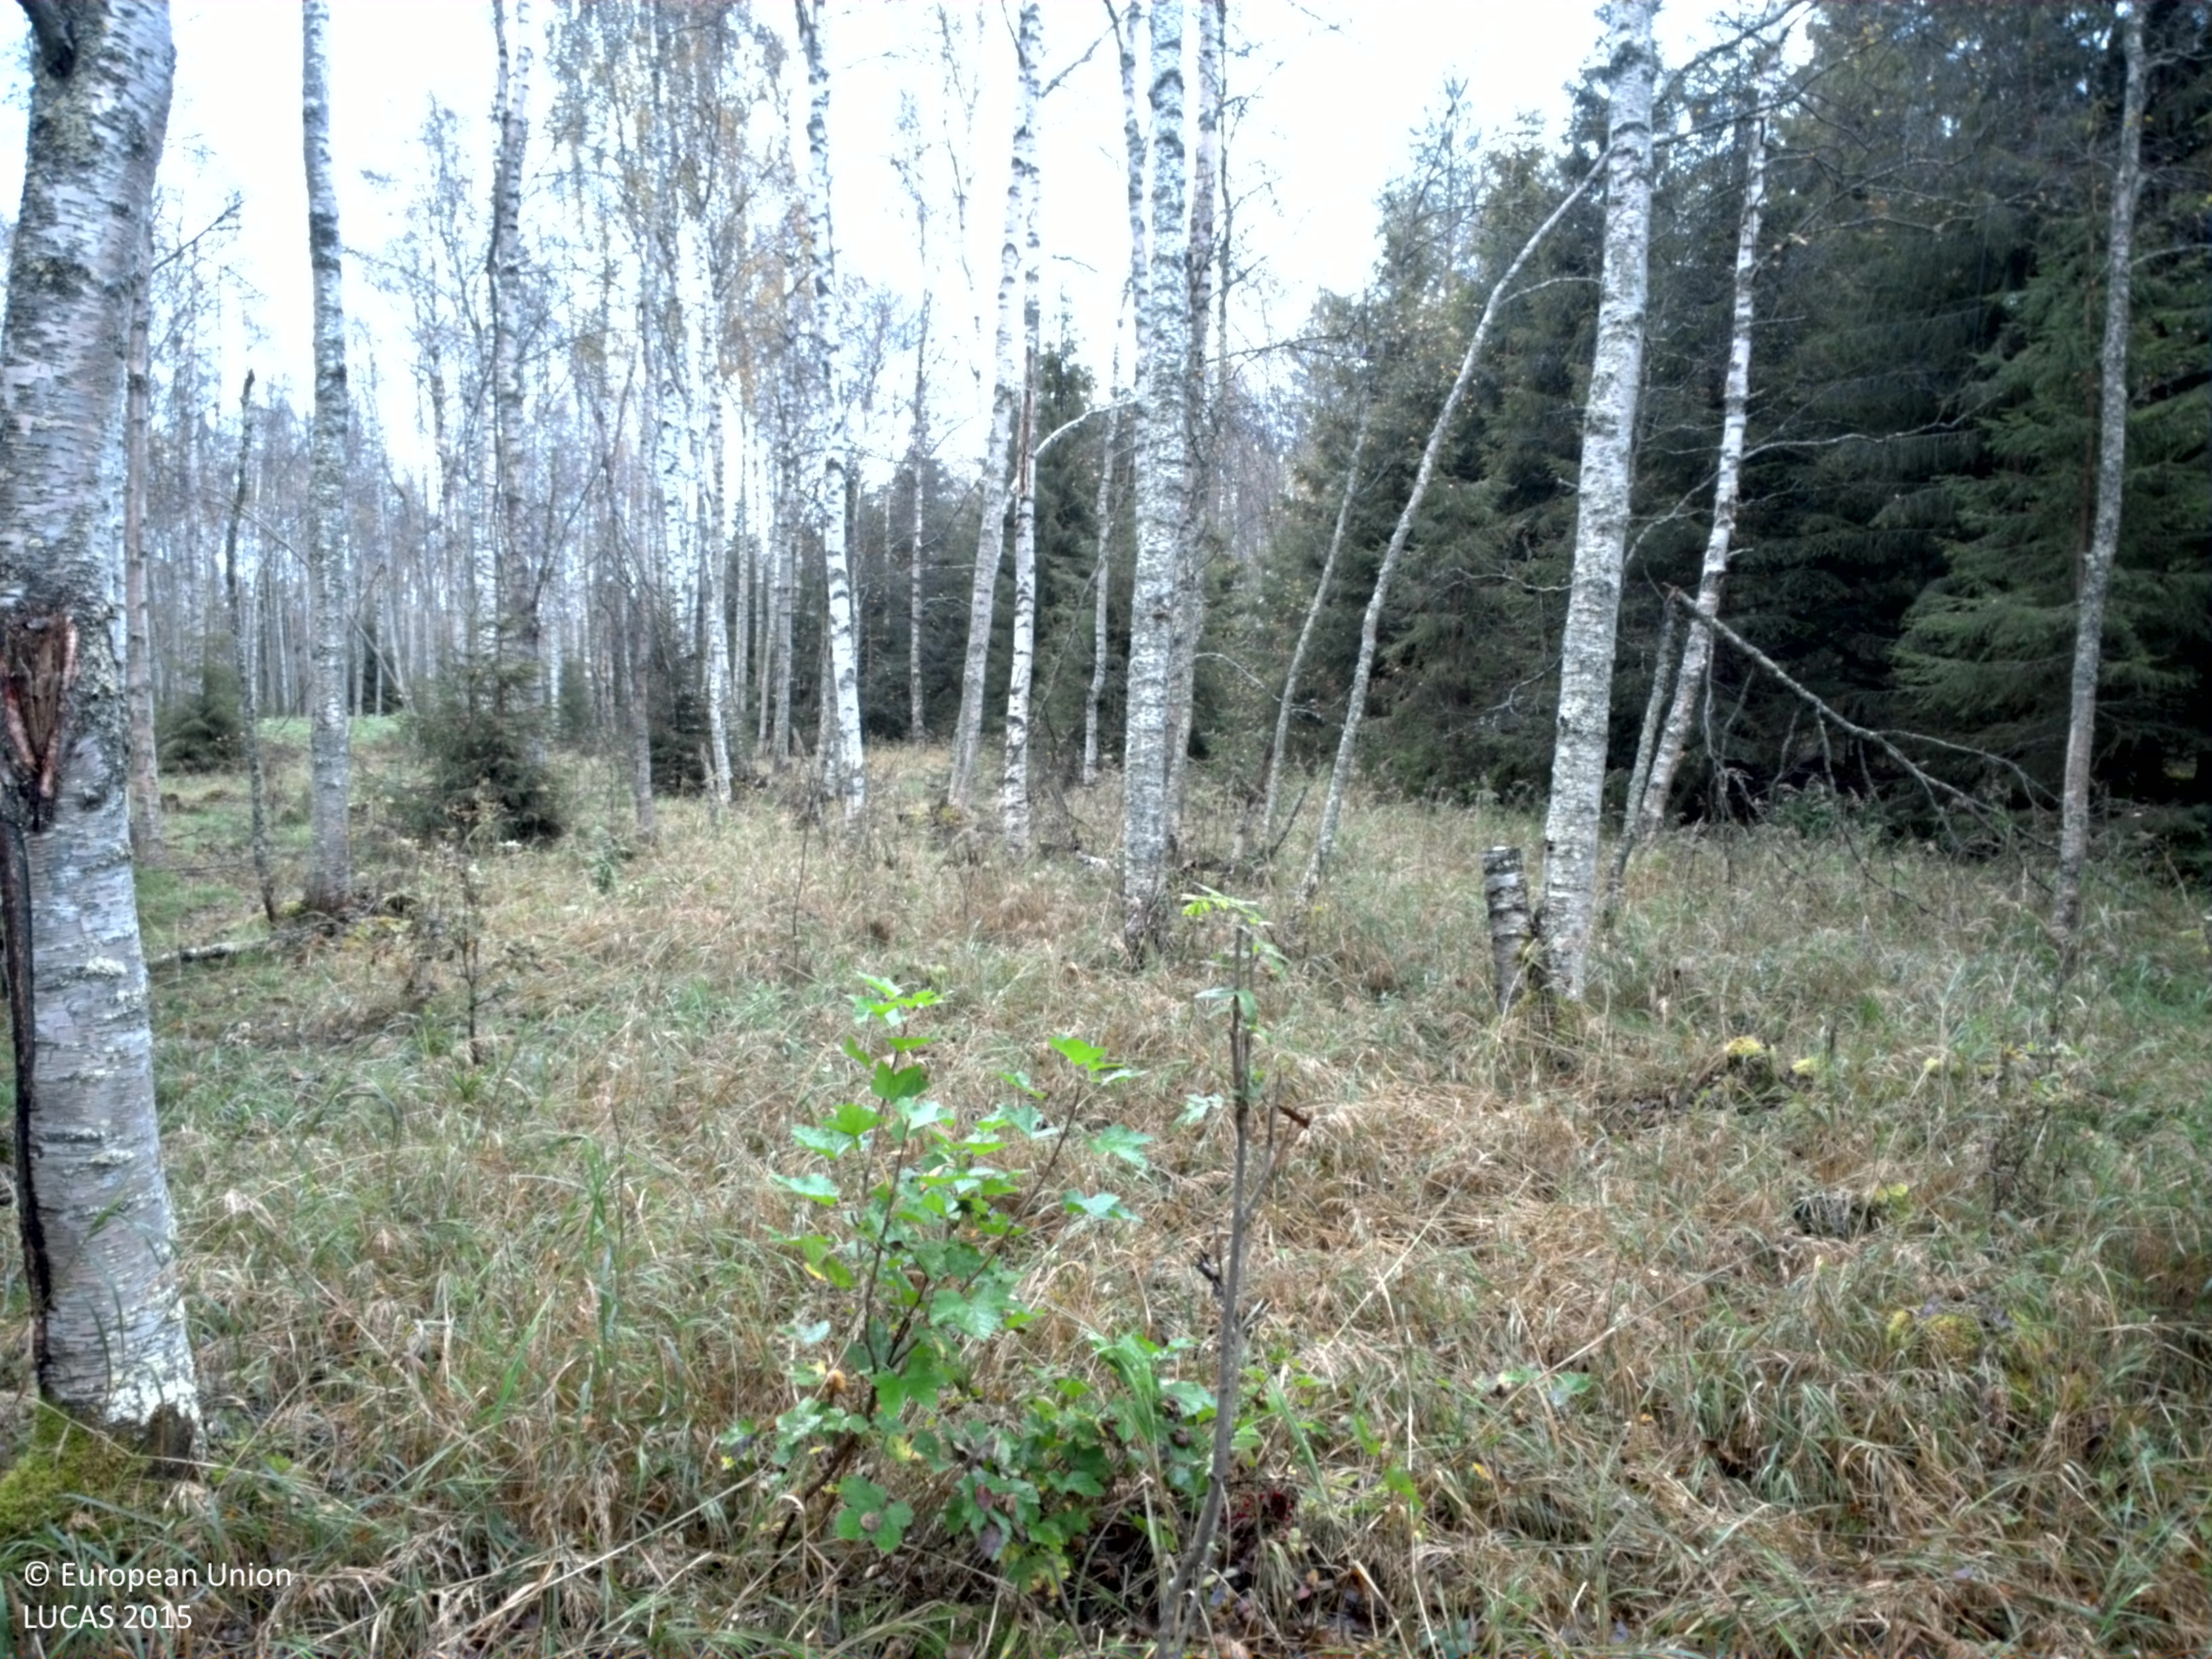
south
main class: Woodland
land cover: Broadleaved woodland
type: non-riverine alder, birch or aspen forest
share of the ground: 50 - 75 %
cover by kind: broadleaved forest trees 45 %, herbaceous plants 40 %, coniferous forest trees 10 %, shrubs 5 %
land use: Forestry
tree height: > 5 m
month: September
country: SE
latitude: 65.6633
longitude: 22.0033
